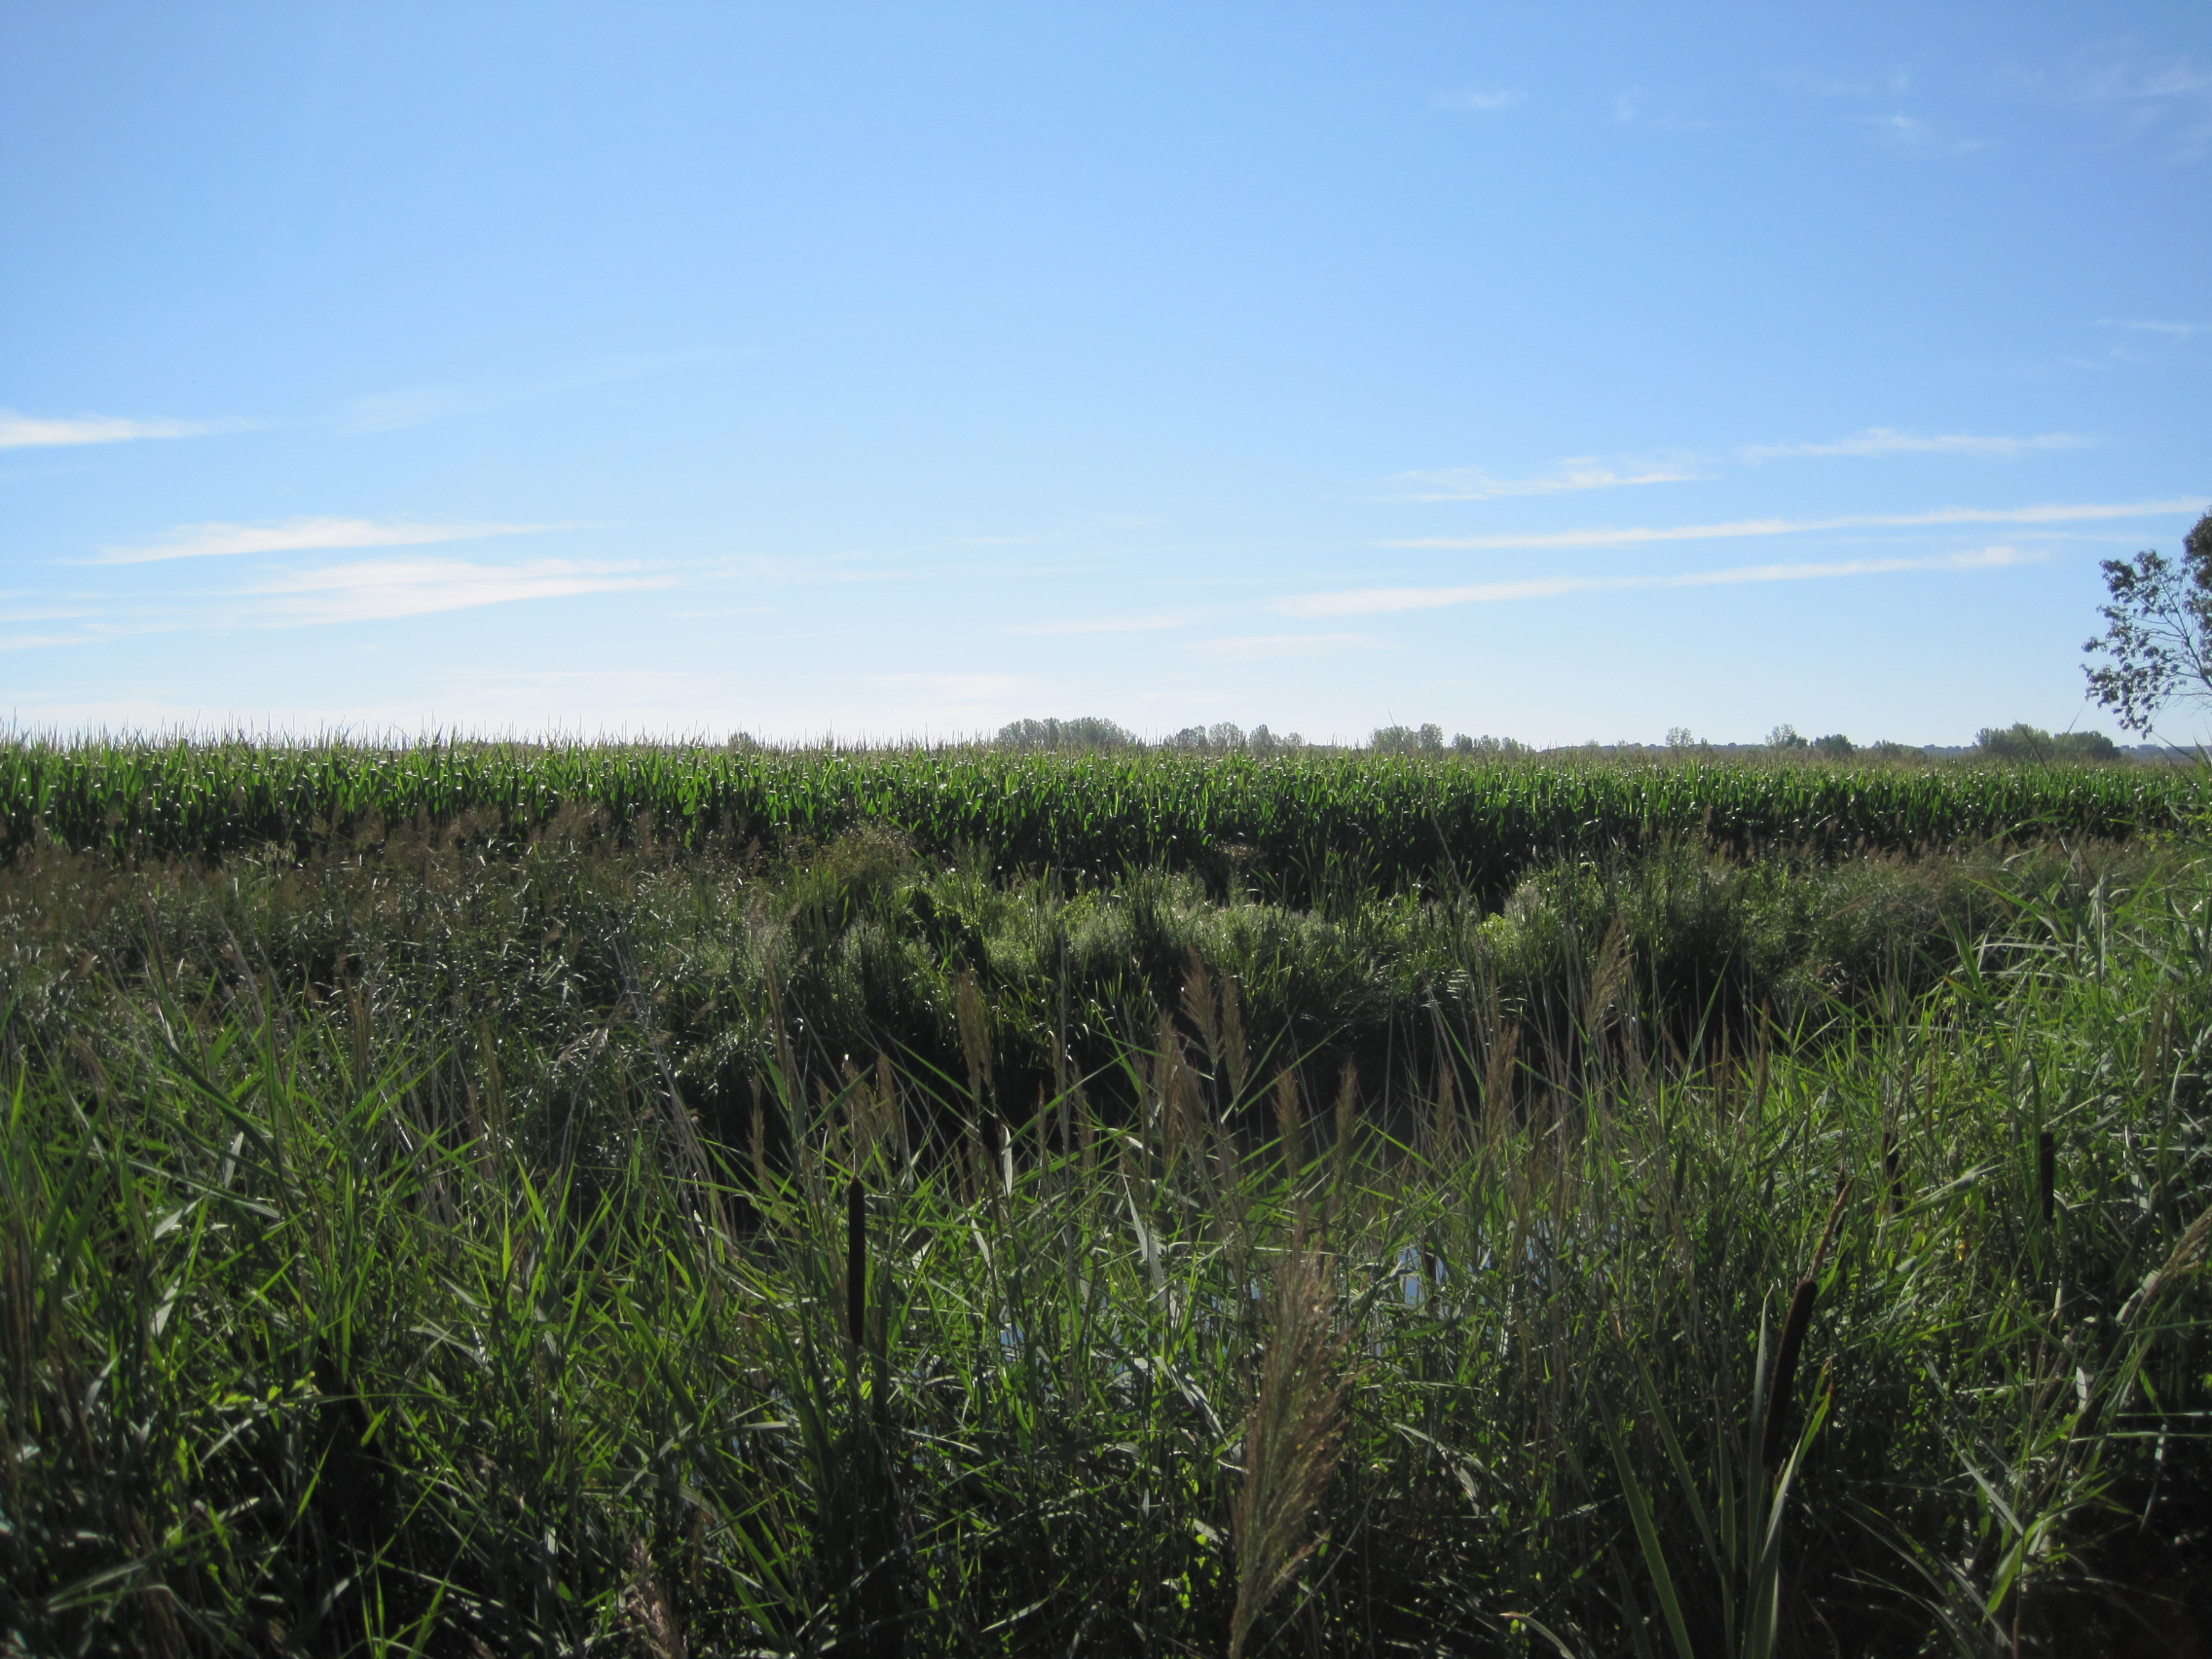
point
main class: Grassland
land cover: Grassland without tree/shrub cover
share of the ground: > 75 %
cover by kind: herbaceous plants 100 %
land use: Semi-natural and natural areas not in use
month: July
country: ES
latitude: 42.0793
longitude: -5.5998
